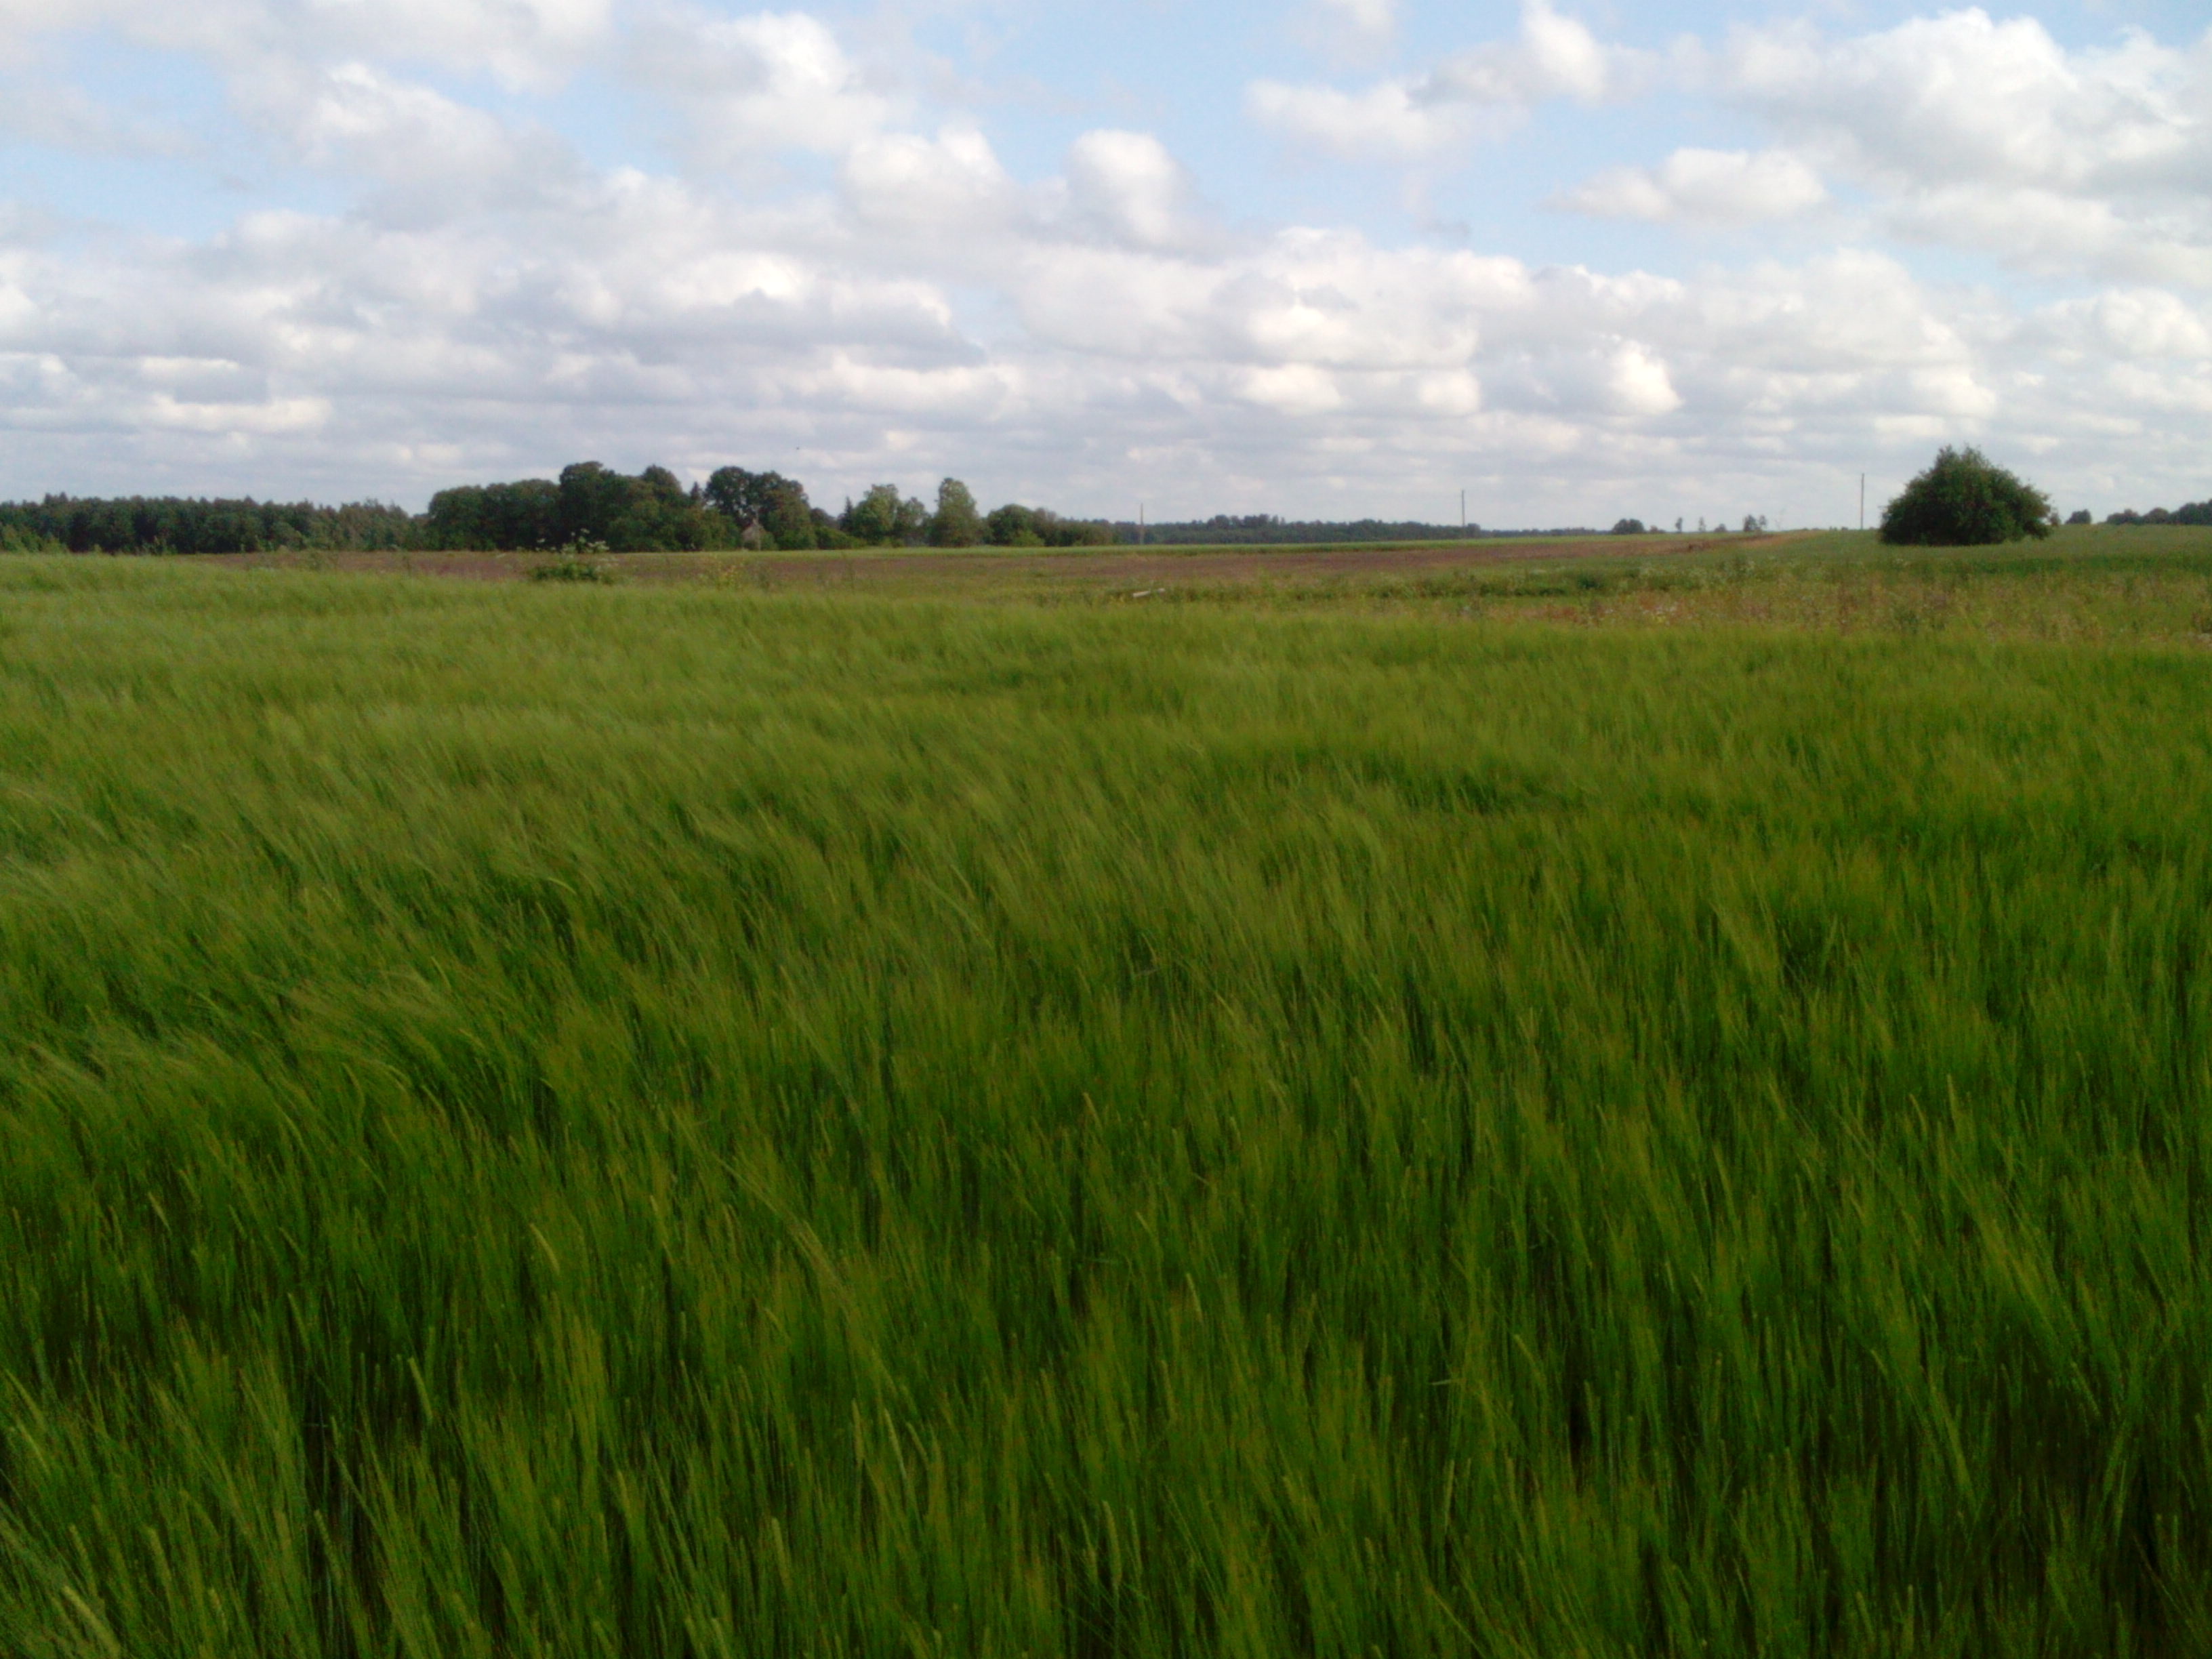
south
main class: Cropland
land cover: Barley
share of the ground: > 75 %
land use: Agriculture (excluding fallow land and kitchen gardens)
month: July
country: LV
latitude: 56.9820
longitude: 22.4447
